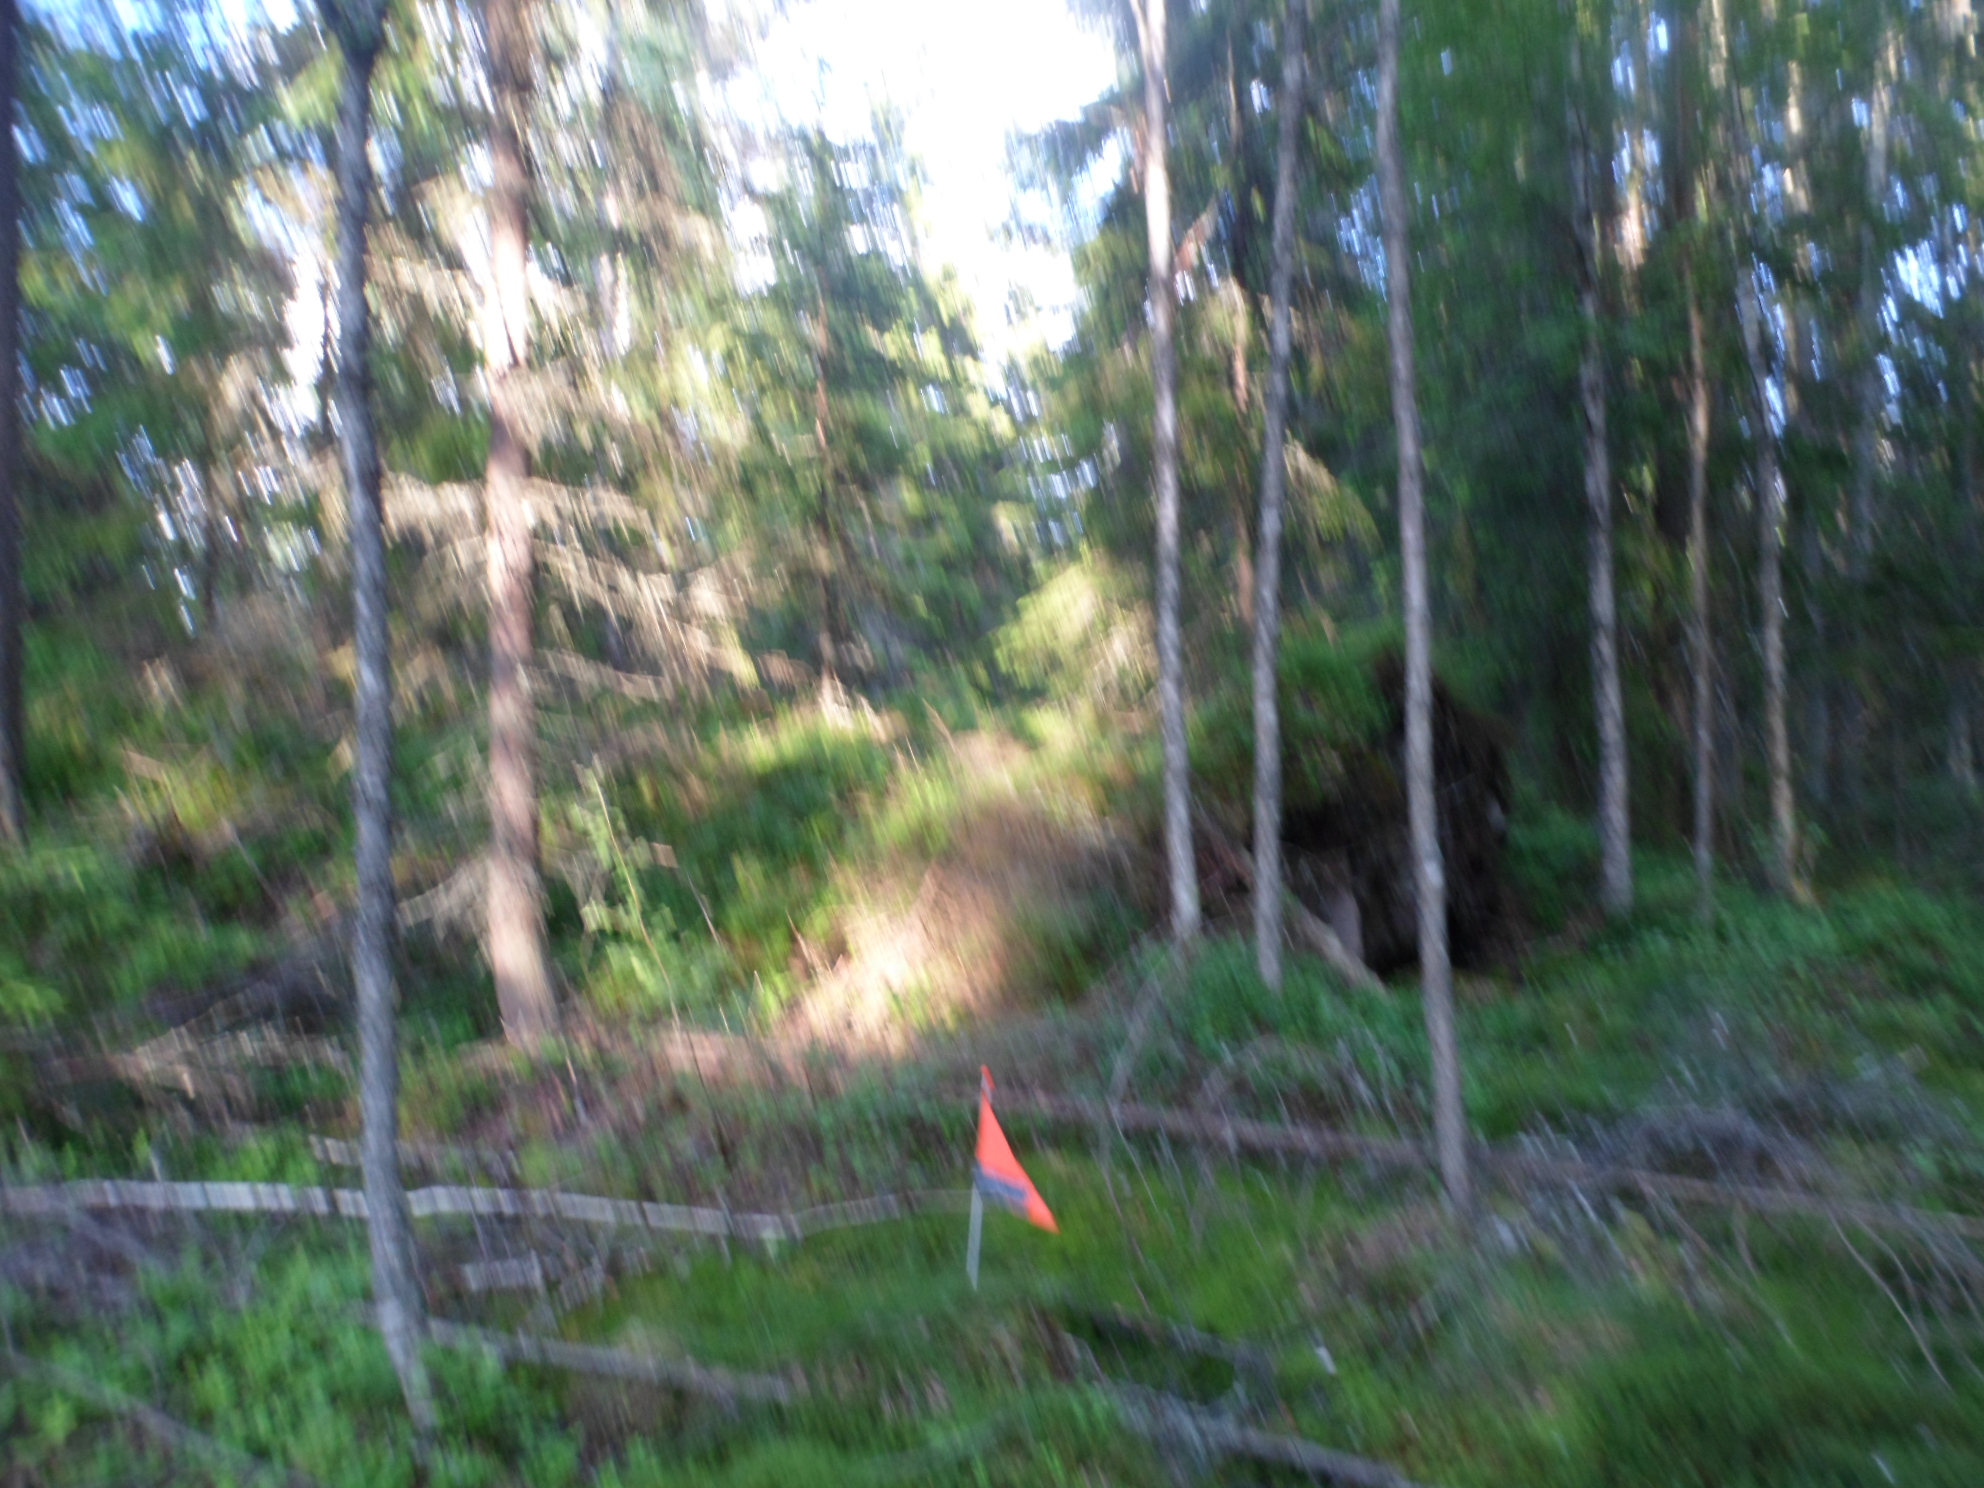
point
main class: Woodland
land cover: Spruce dominated mixed woodland
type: boreal forest
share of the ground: 50 - 75 %
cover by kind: broadleaved forest trees 35 %, coniferous forest trees 25 %, lichens and mosses 25 %, shrubs 10 %, herbaceous plants 5 %
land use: Forestry
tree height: > 5 m
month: June
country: SE
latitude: 57.1135
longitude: 15.0996
